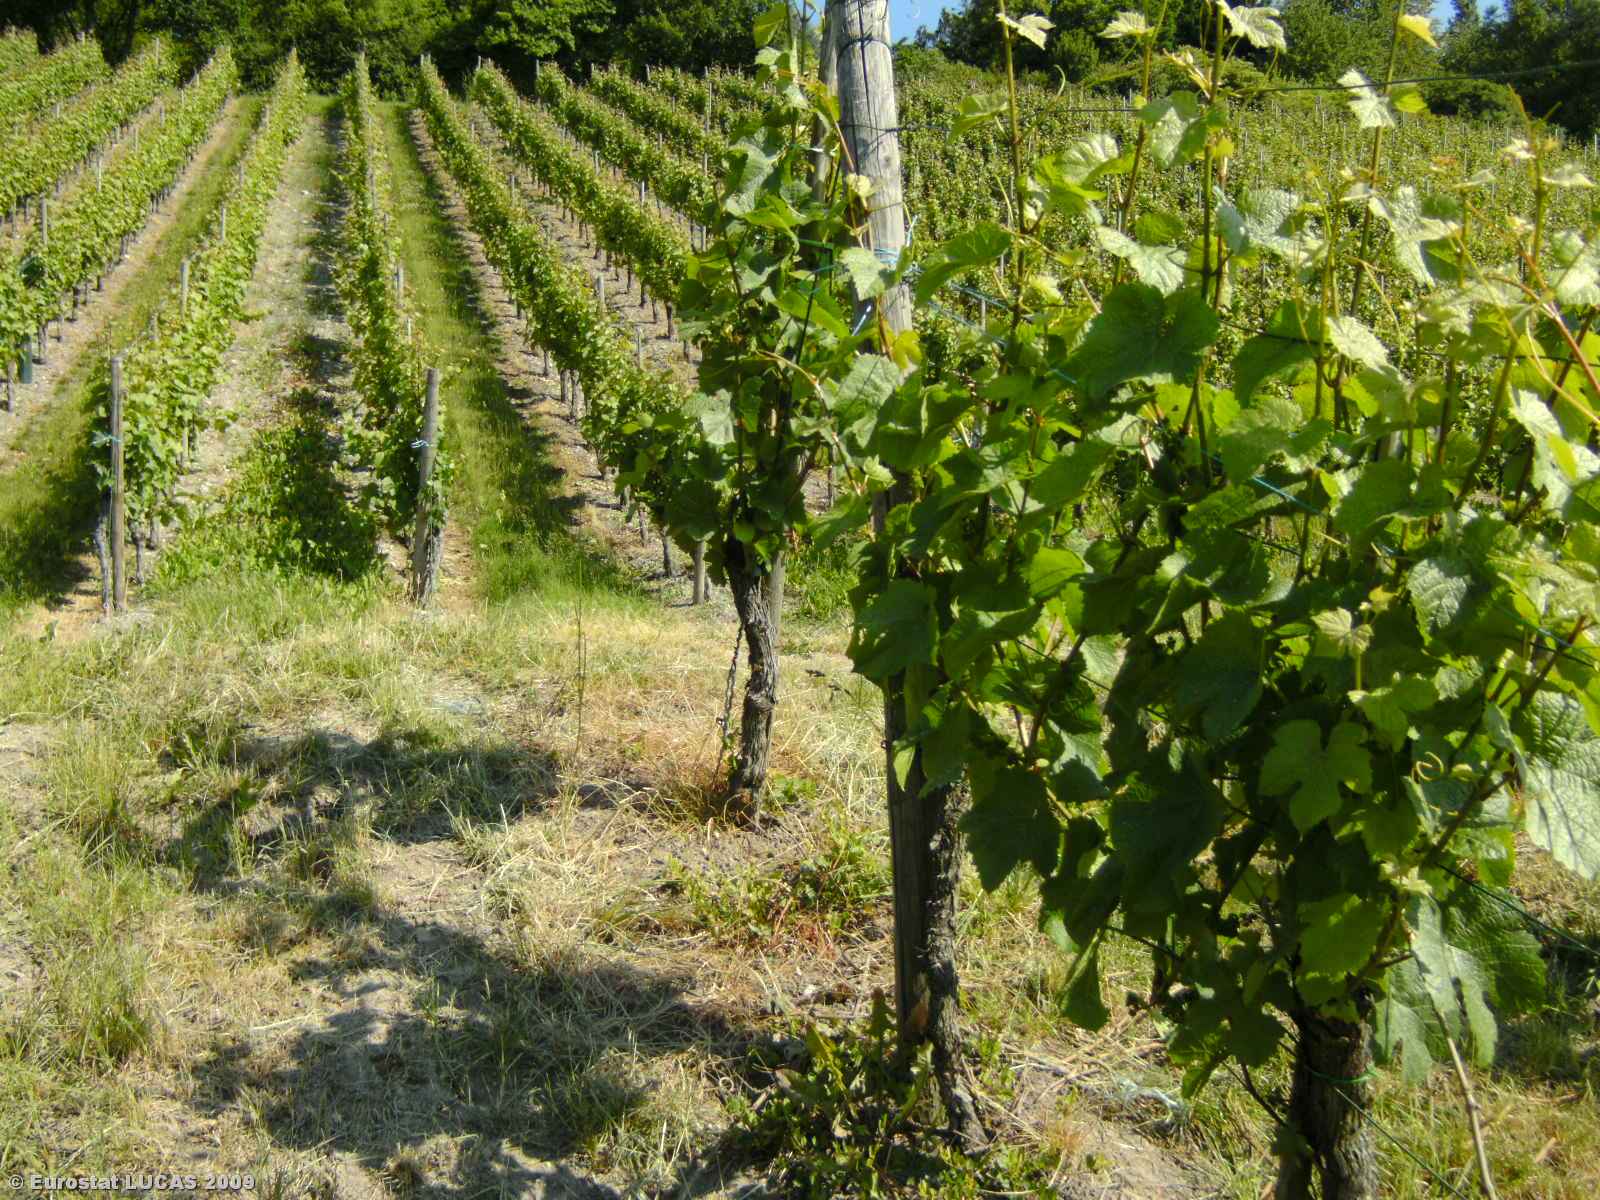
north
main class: Cropland
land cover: Vineyards
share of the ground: 25 - 50 %
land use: Agriculture (excluding fallow land and kitchen gardens)
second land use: Amenities, museums, leisure
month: June
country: LU
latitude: 49.5314
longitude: 6.3382
